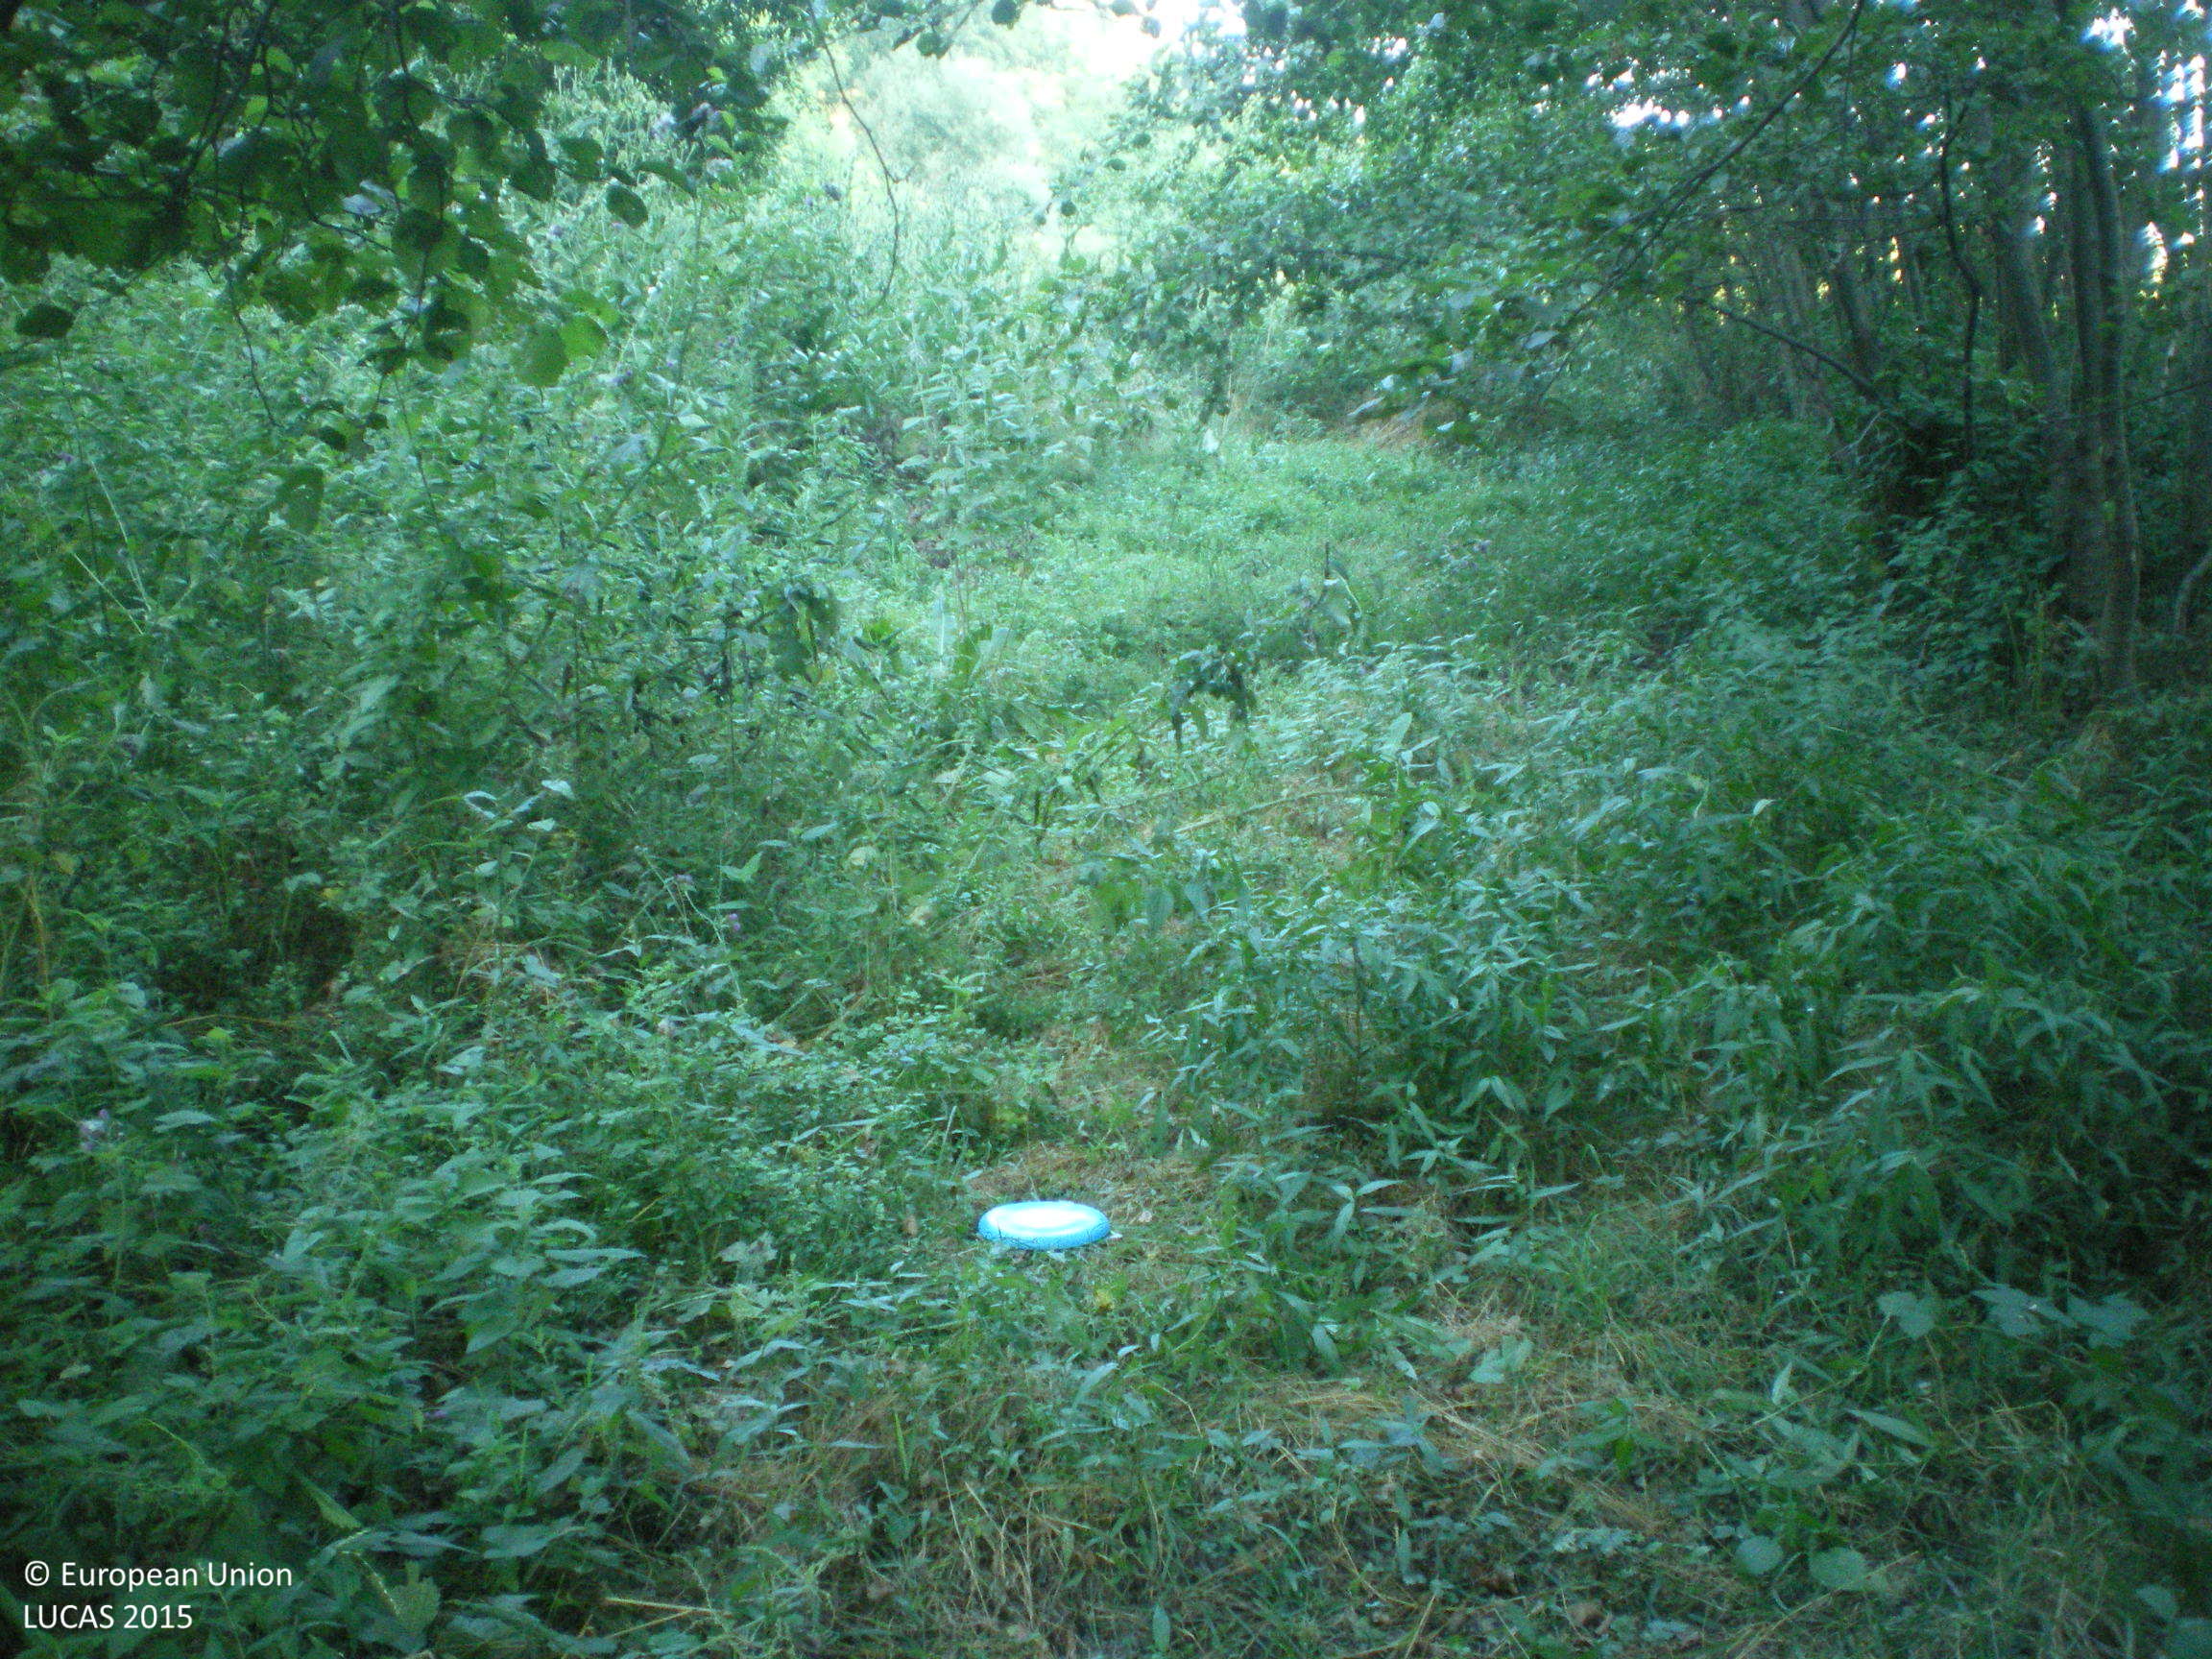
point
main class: Woodland
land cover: Broadleaved woodland
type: mesophytic deciduous forest
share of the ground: > 75 %
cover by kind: broadleaved forest trees 85 %, herbaceous plants 15 %
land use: Forestry
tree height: > 5 m
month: July
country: BG
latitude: 42.6151
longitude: 25.2191
